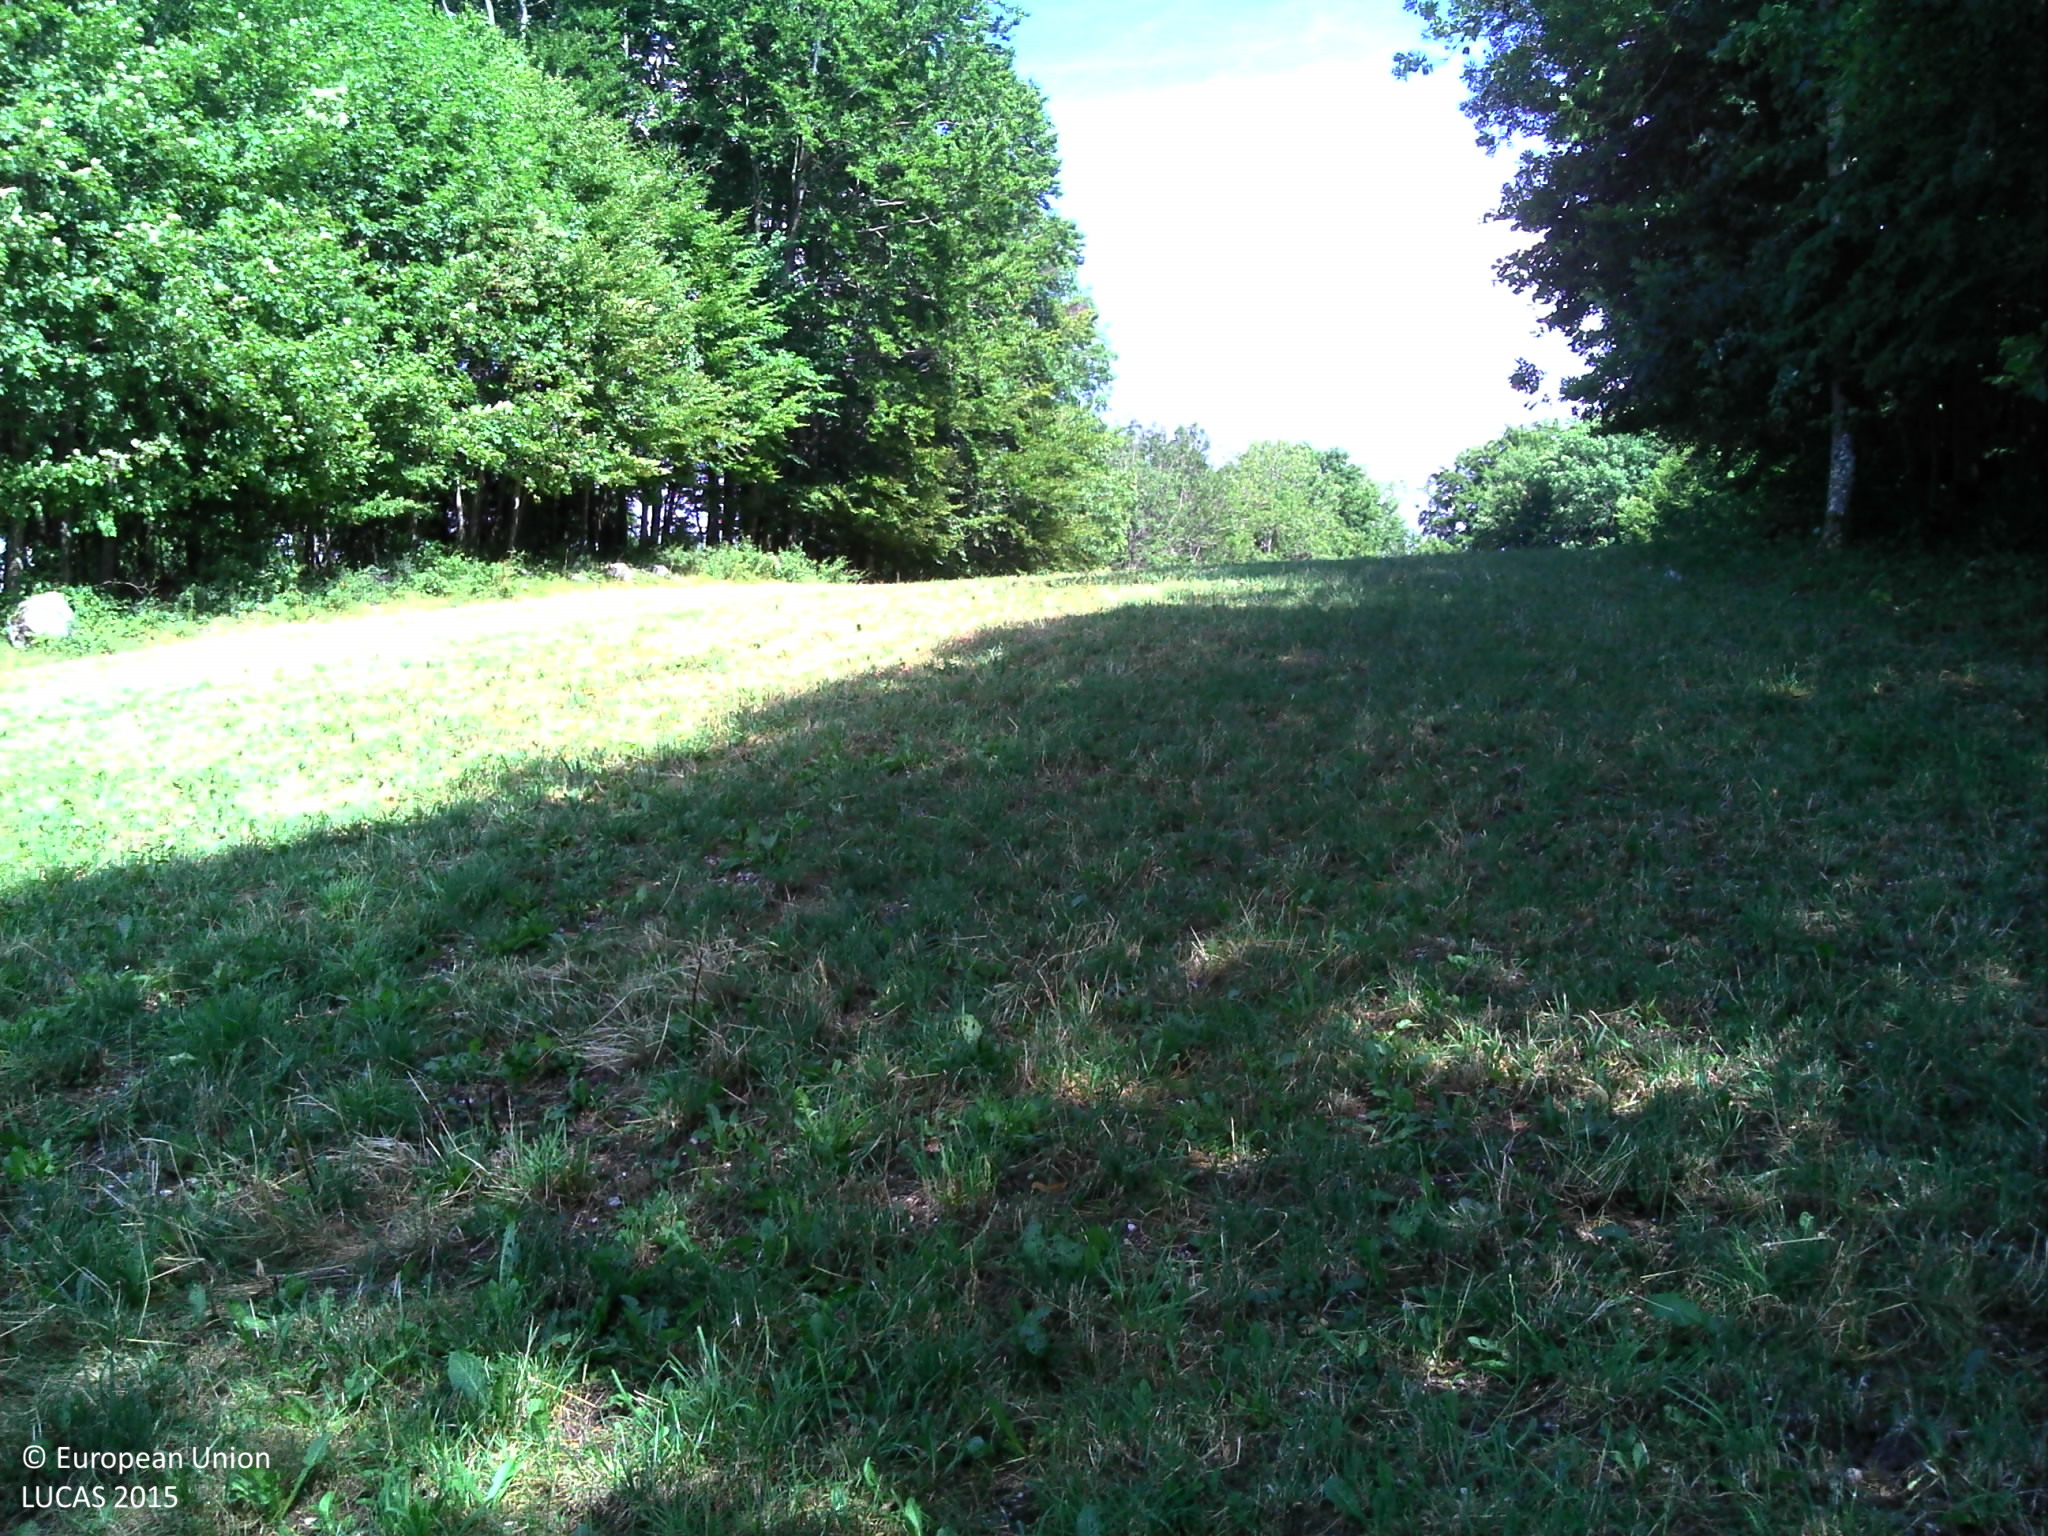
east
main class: Grassland
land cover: Grassland without tree/shrub cover
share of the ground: > 75 %
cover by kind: herbaceous plants 100 %
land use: Agriculture (excluding fallow land and kitchen gardens)
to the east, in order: Grassland without tree/shrub cover; Broadleaved woodland; Grassland without tree/shrub cover; Broadleaved woodland; Rock outcrops; Grassland without tree/shrub cover; Rock outcrops; Fences; Grassland without tree/shrub cover; Fences; Grassland without tree/shrub cover
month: July
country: FR
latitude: 46.7655
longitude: 6.0612
